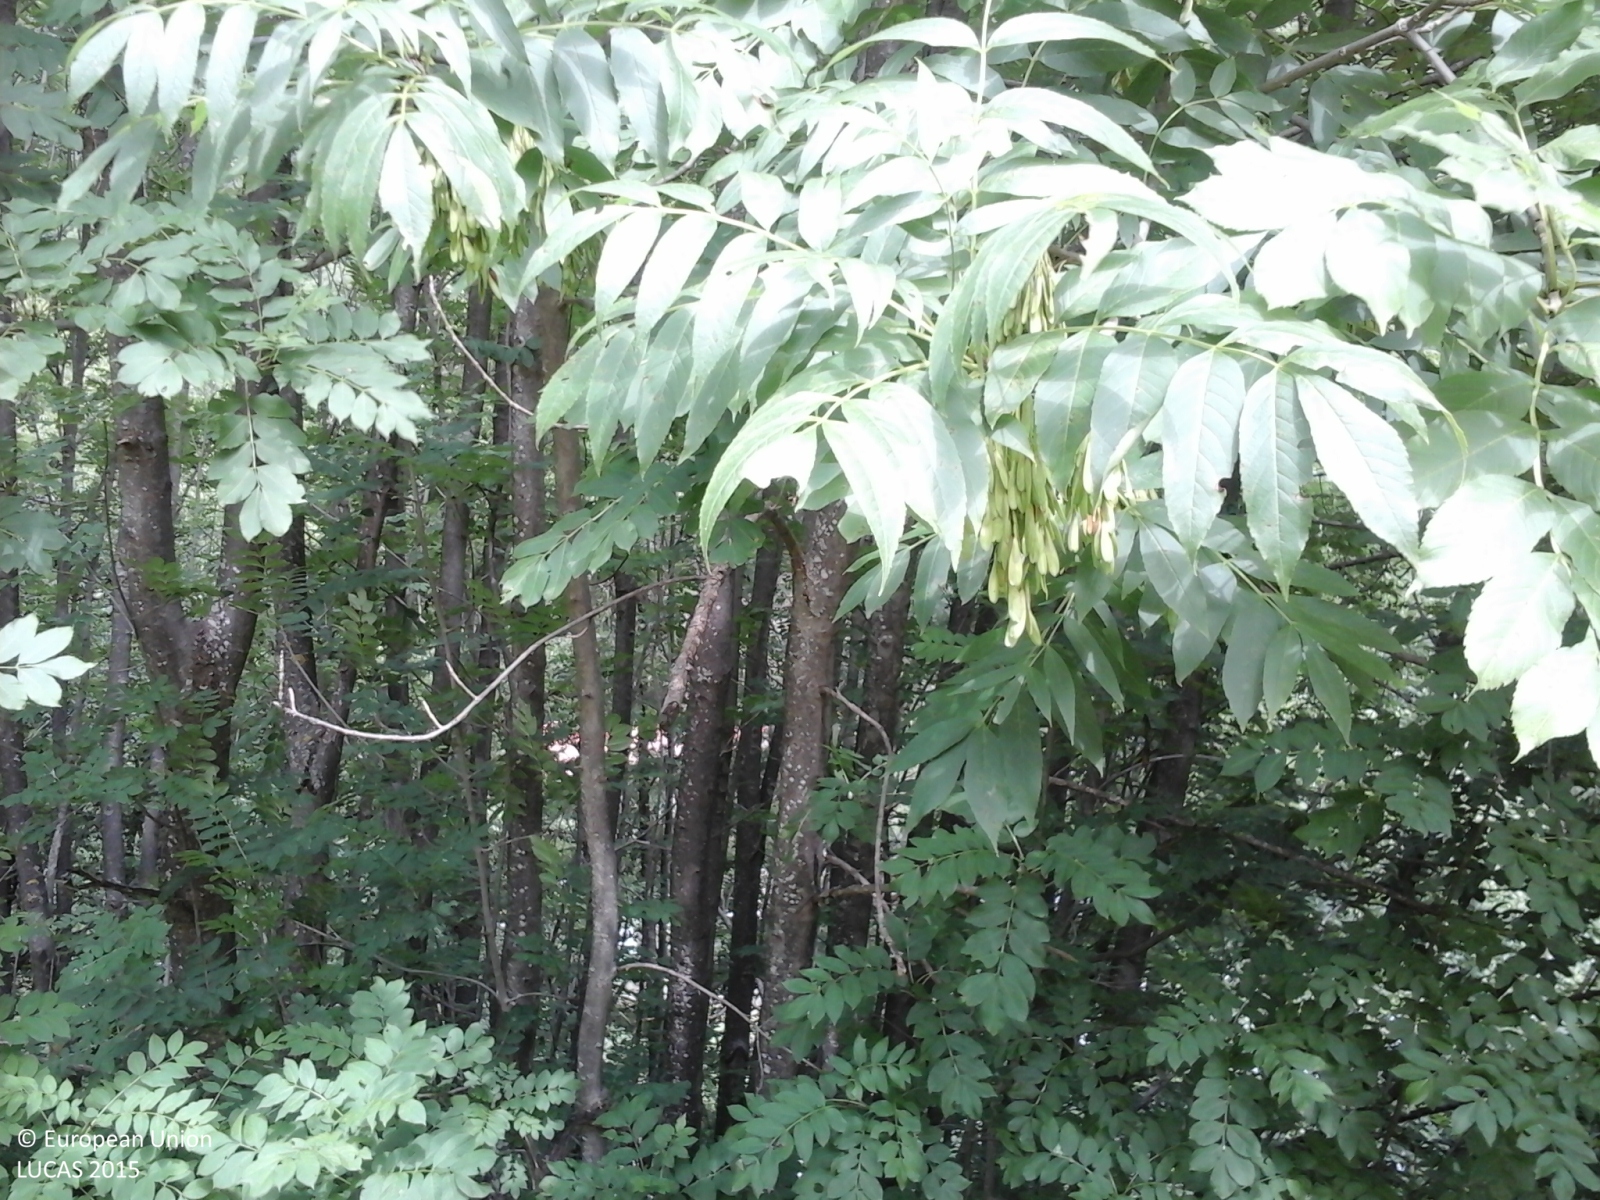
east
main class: Grassland
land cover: Grassland without tree/shrub cover
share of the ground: > 75 %
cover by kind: herbaceous plants 100 %
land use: Agriculture (excluding fallow land and kitchen gardens)
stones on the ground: < 10 %
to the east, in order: Grassland without tree/shrub cover; Broadleaved woodland; Paved roads, cycling and walking lanes; Broadleaved woodland; Inland fresh running water; Artificial constructions in urban areas; Broadleaved woodland
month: June
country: IT
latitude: 44.2379
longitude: 7.8387
